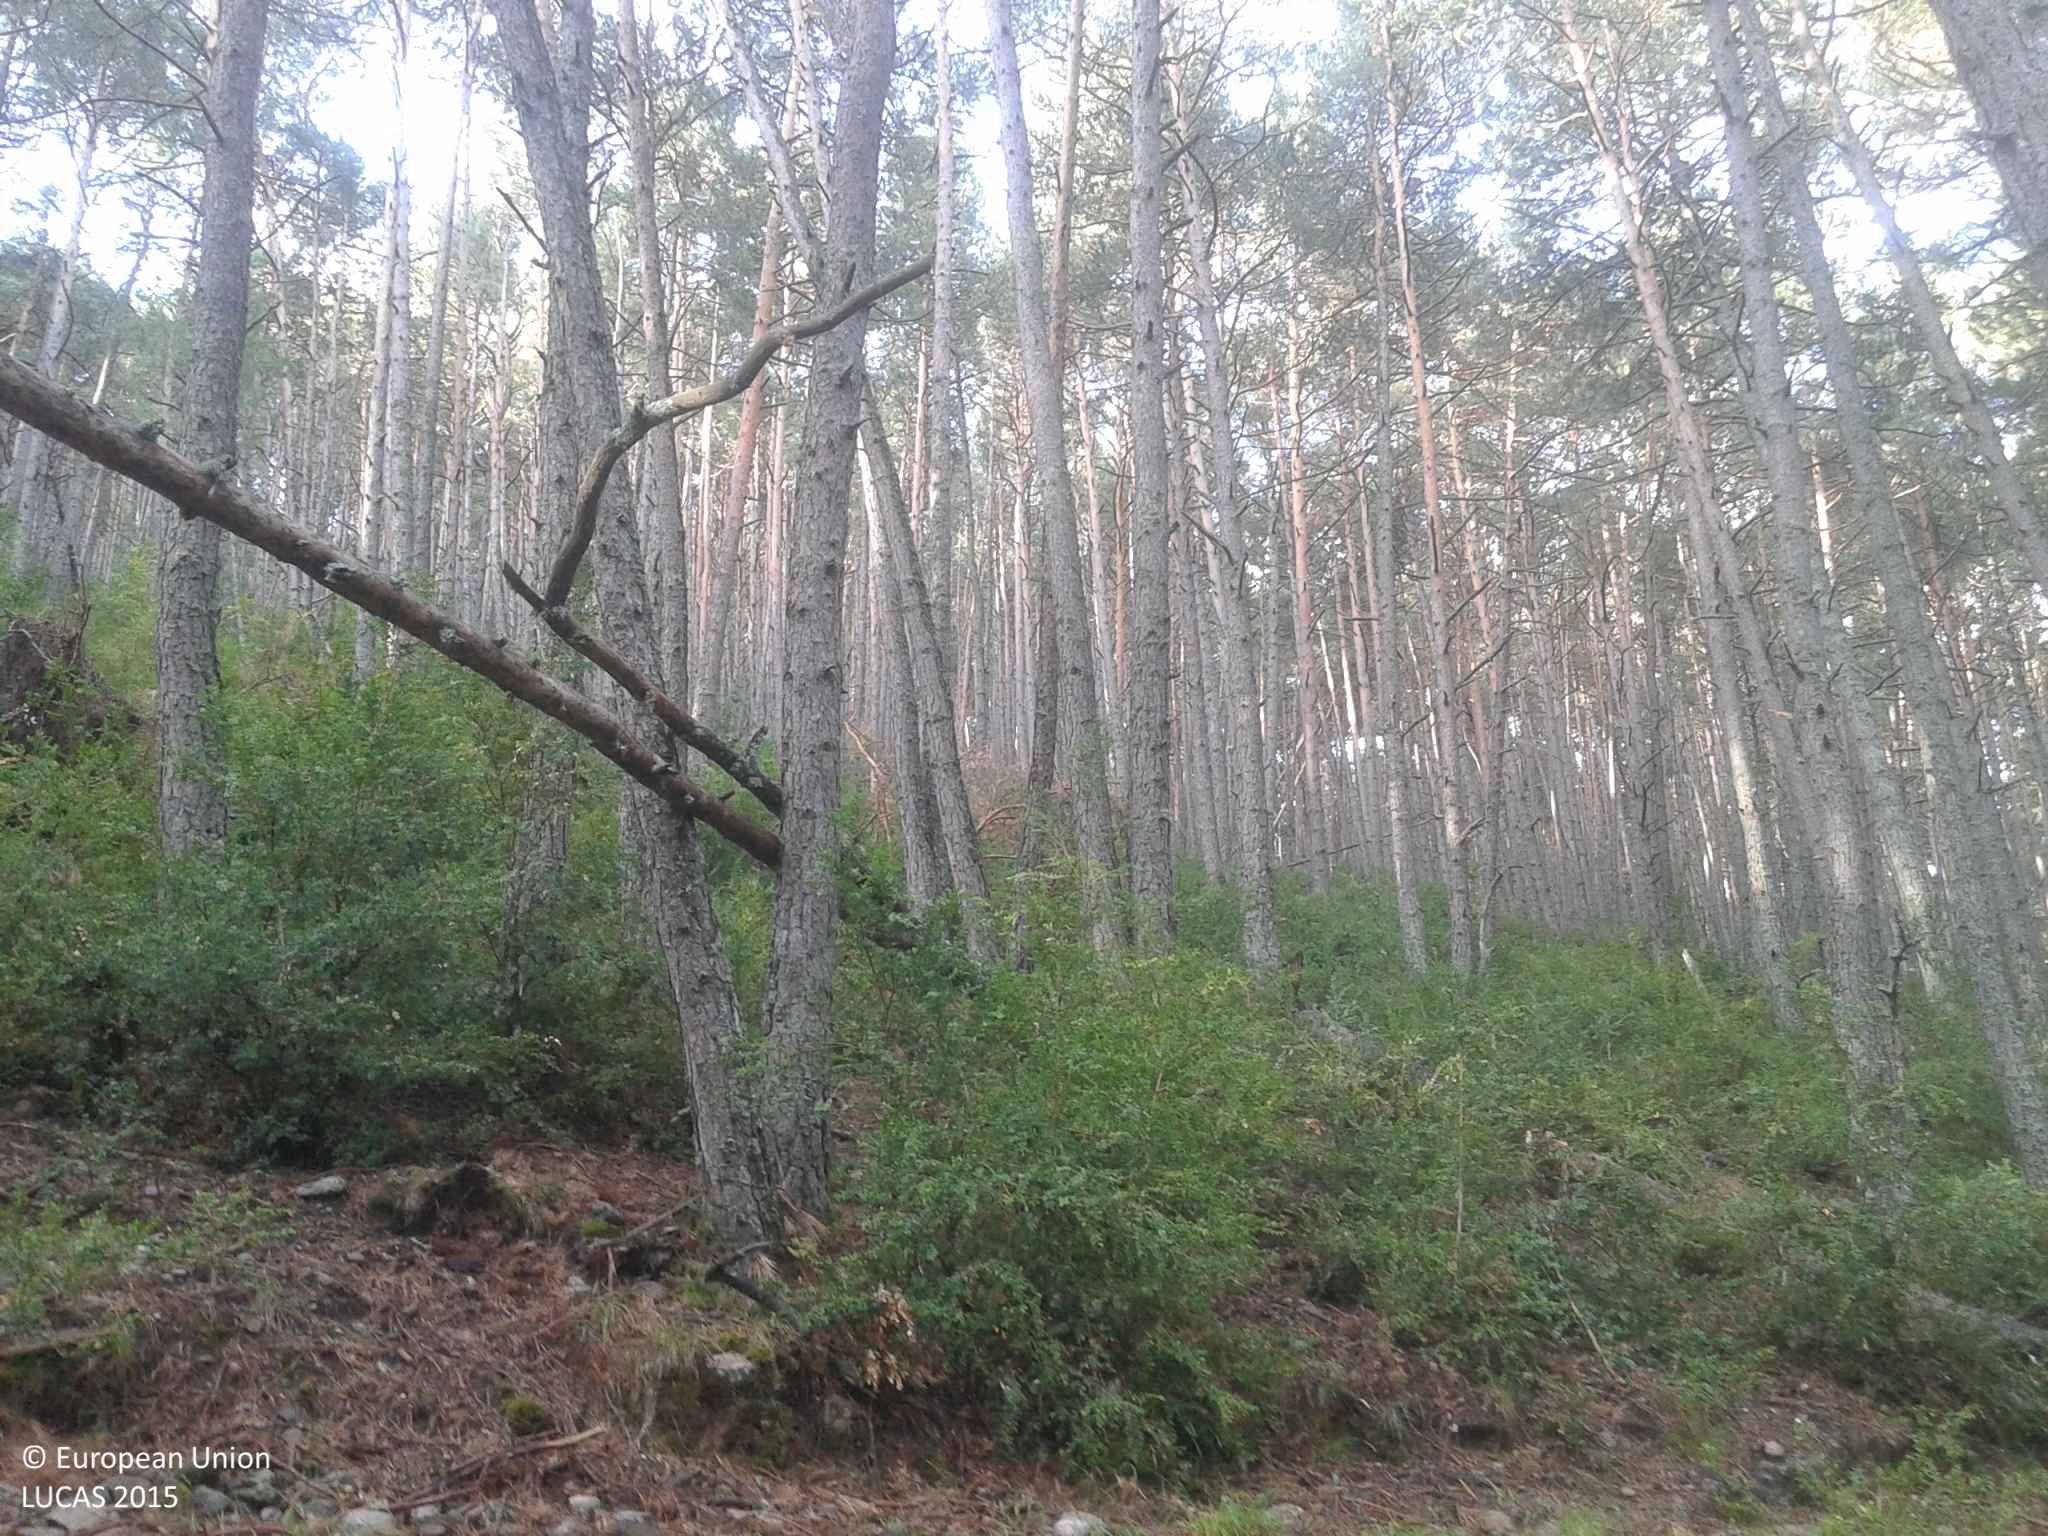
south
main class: Woodland
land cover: Pine dominated coniferous woodland
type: coniferous forest of the mediterranean region
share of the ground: > 75 %
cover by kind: coniferous forest trees 90 %, shrubs 5 %, herbaceous plants 5 %
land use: Forestry
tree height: > 5 m
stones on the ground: > 50 %
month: August
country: ES
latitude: 42.2594
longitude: 1.0751
